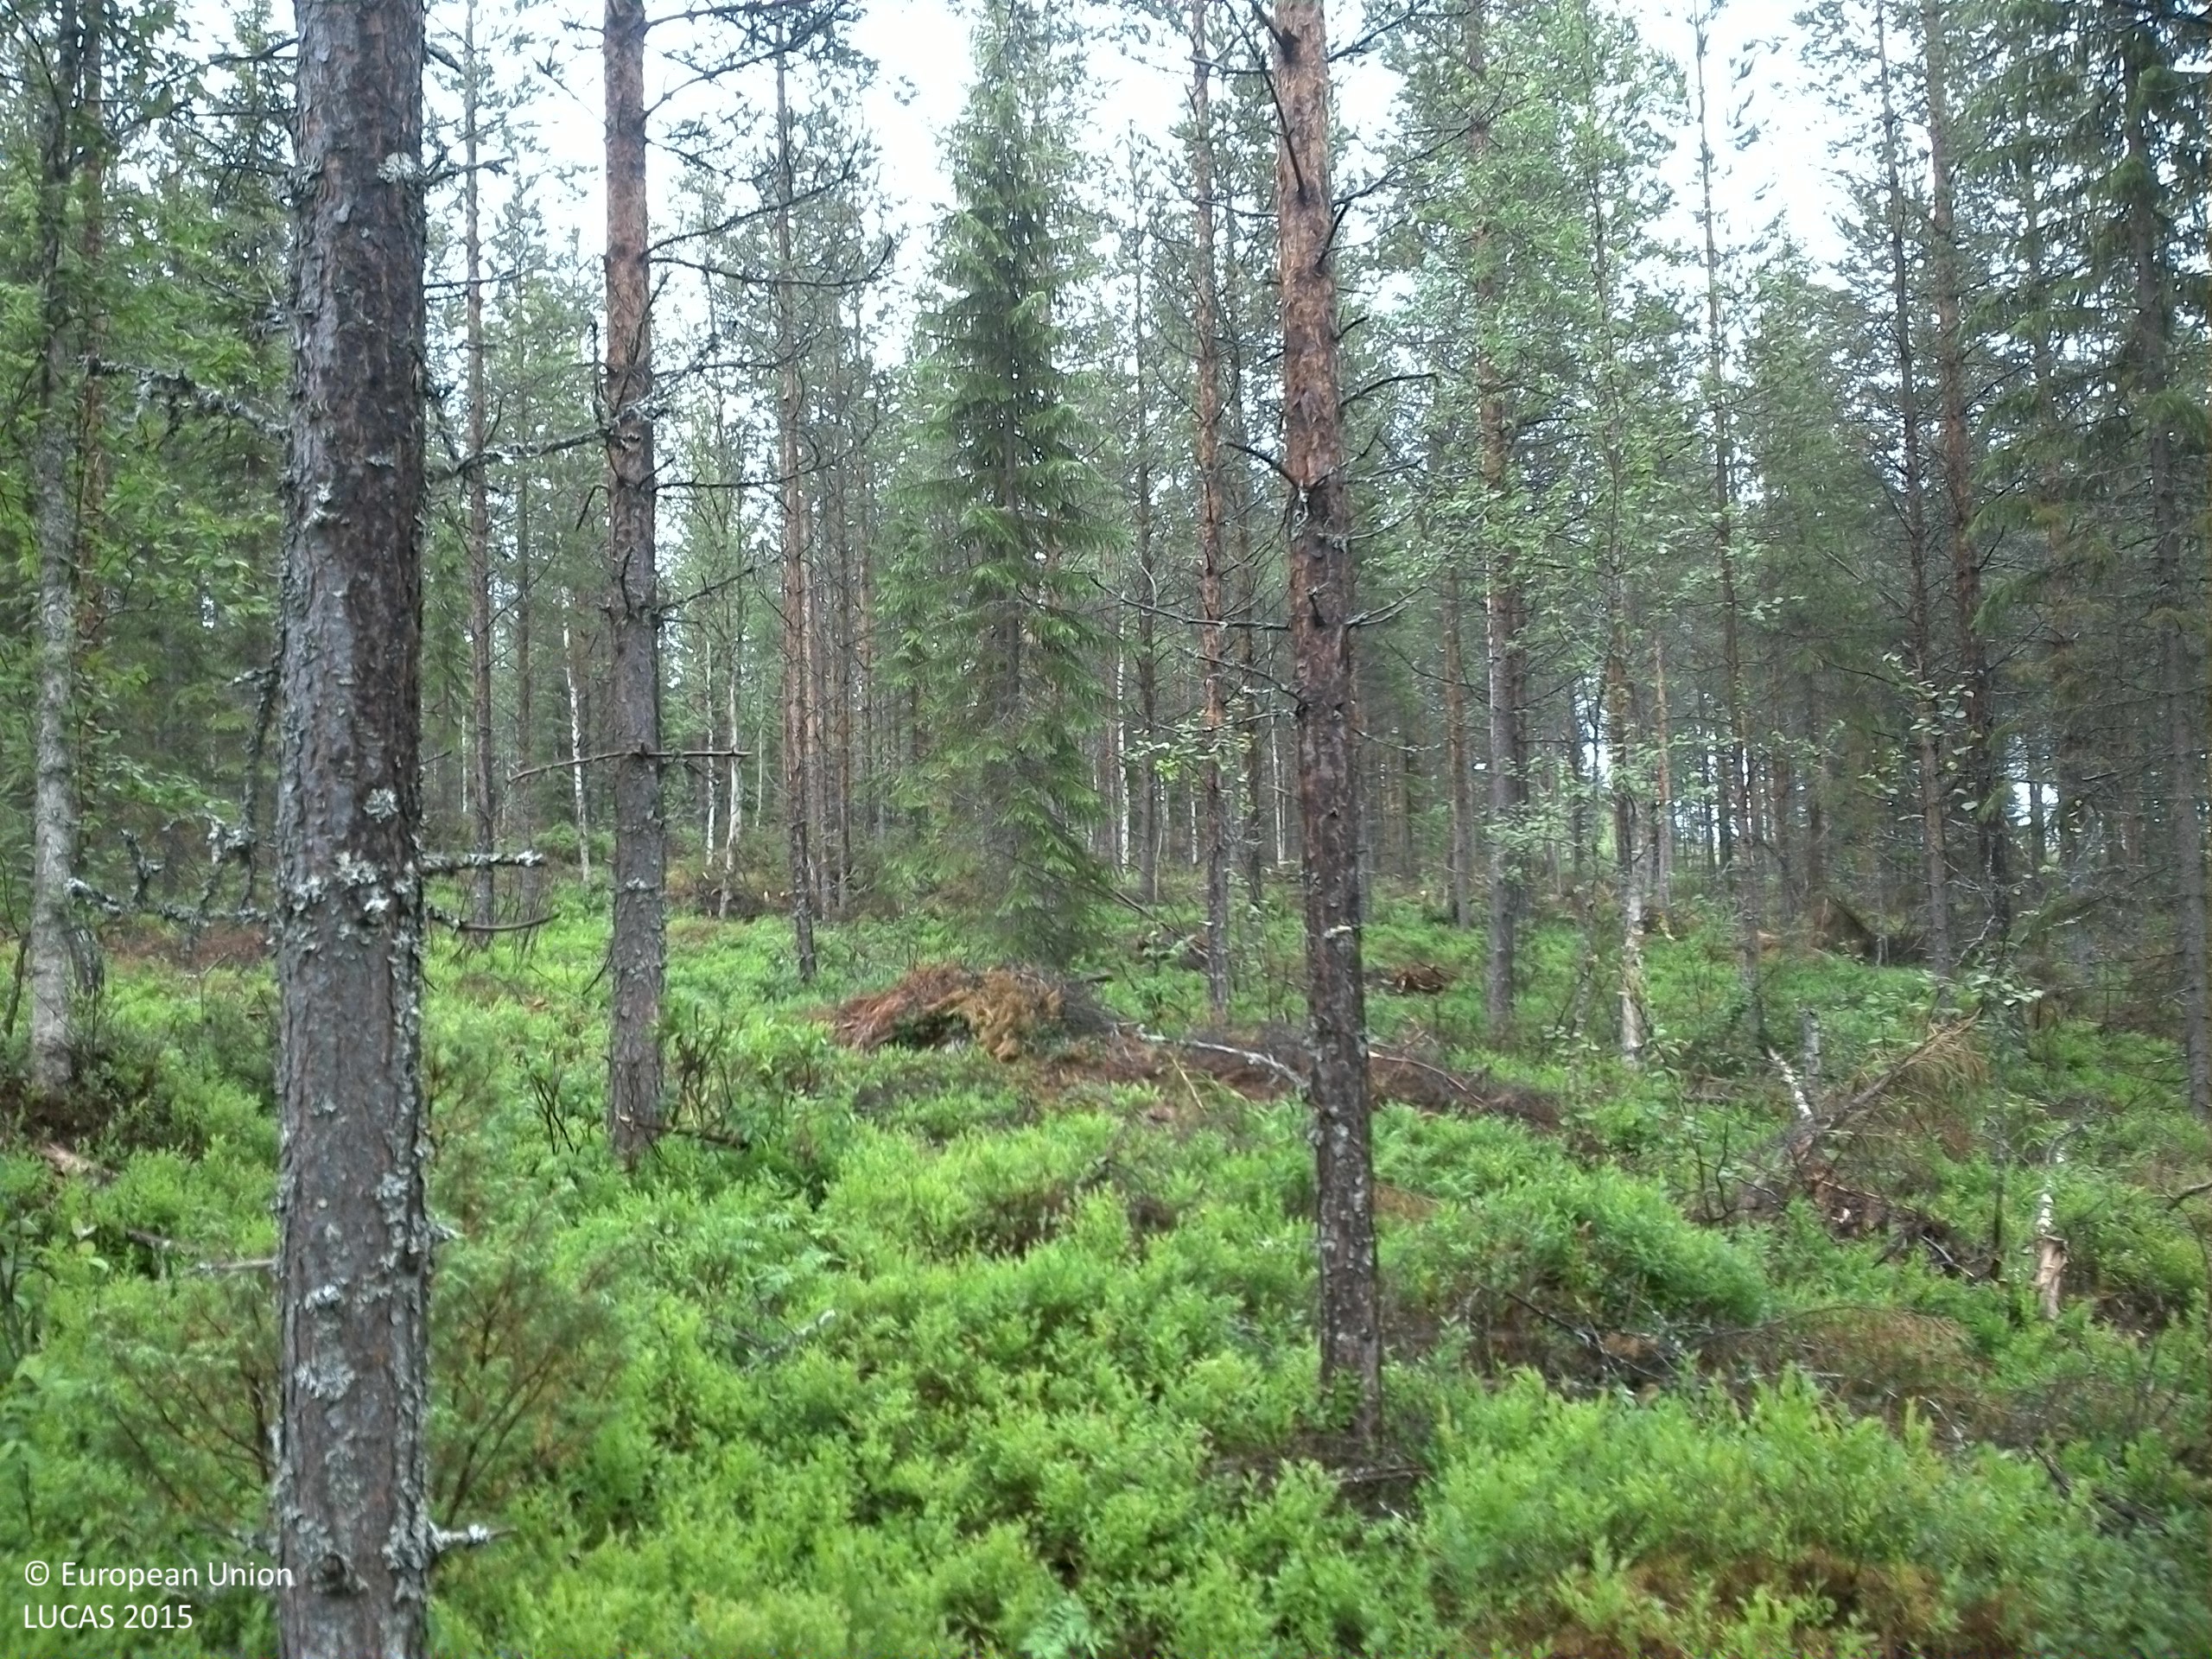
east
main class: Woodland
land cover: Pine dominated mixed woodland
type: boreal forest
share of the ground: 50 - 75 %
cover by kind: coniferous forest trees 45 %, shrubs 20 %, broadleaved forest trees 15 %, herbaceous plants 10 %, lichens and mosses 10 %
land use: Forestry
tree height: > 5 m
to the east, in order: Pine dominated mixed woodland; Pine dominated coniferous woodland; Ditches and canals; Spruce dominated mixed woodland; Spruce dominated coniferous woodland
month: July
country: SE
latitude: 63.6693
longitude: 17.2676
